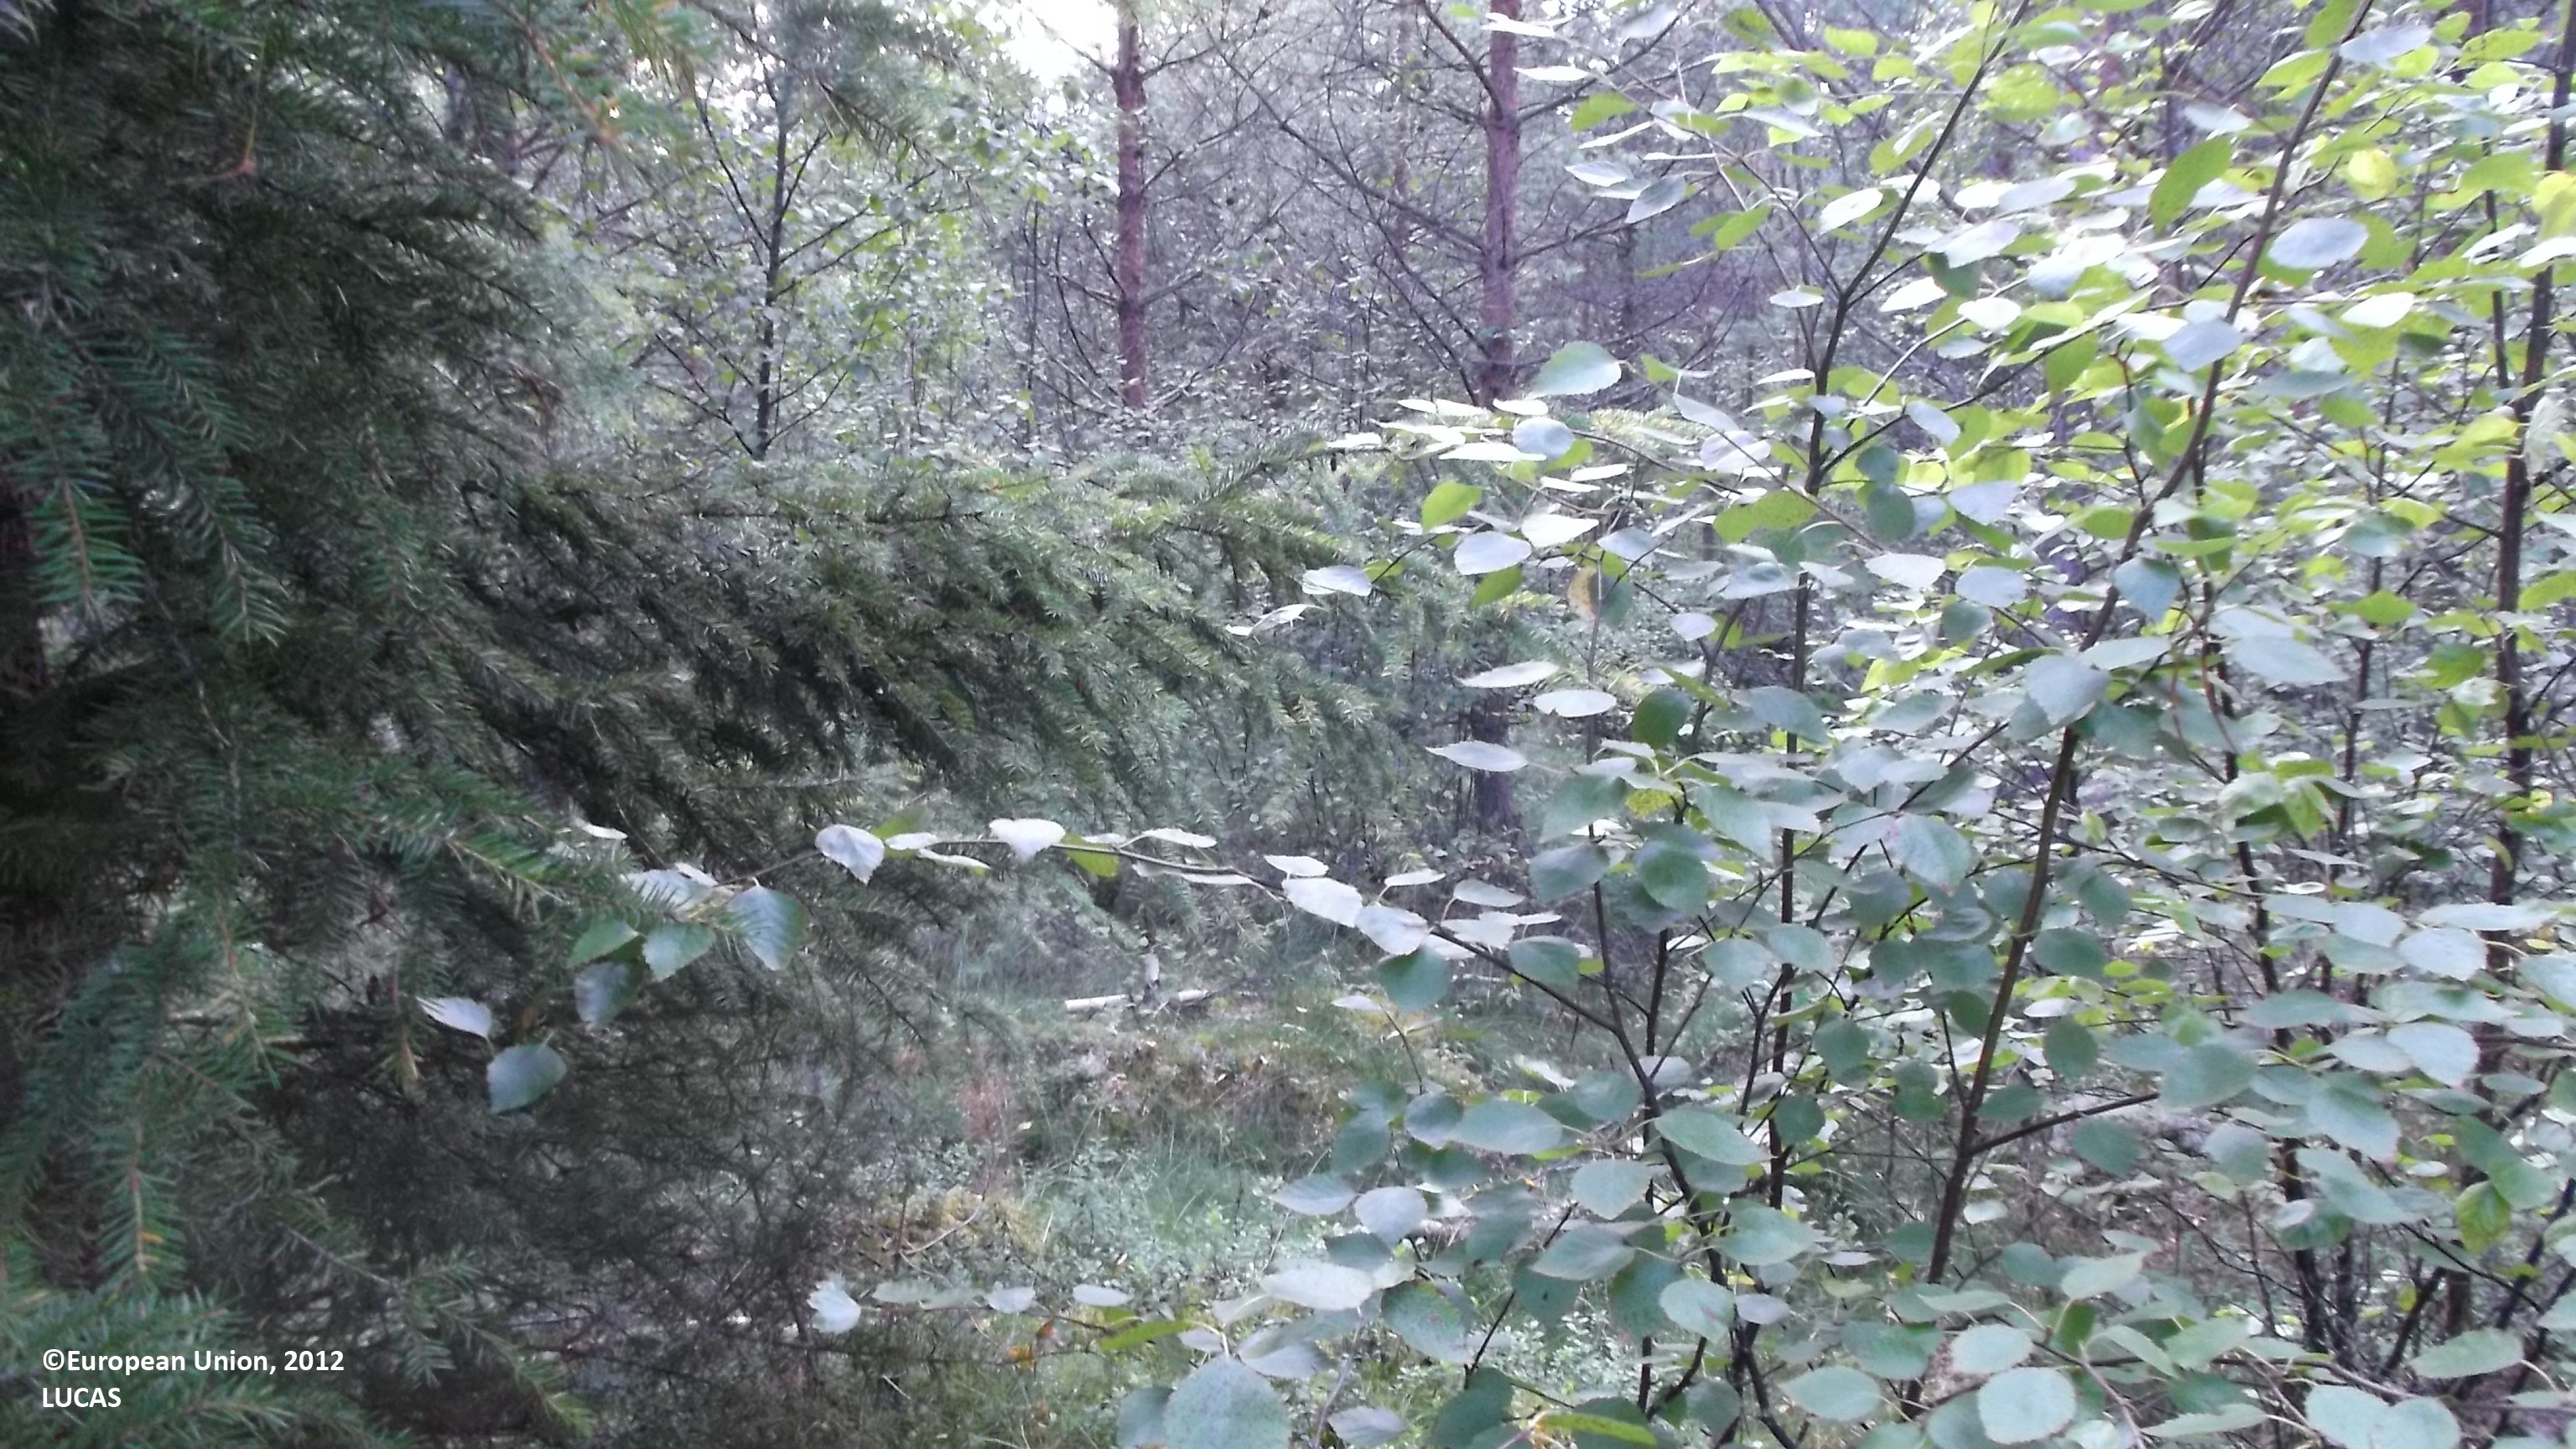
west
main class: Woodland
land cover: Pine dominated mixed woodland
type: boreal forest
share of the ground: 50 - 75 %
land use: Forestry
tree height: > 5 m
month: August
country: FI
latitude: 63.9640
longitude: 23.7217
